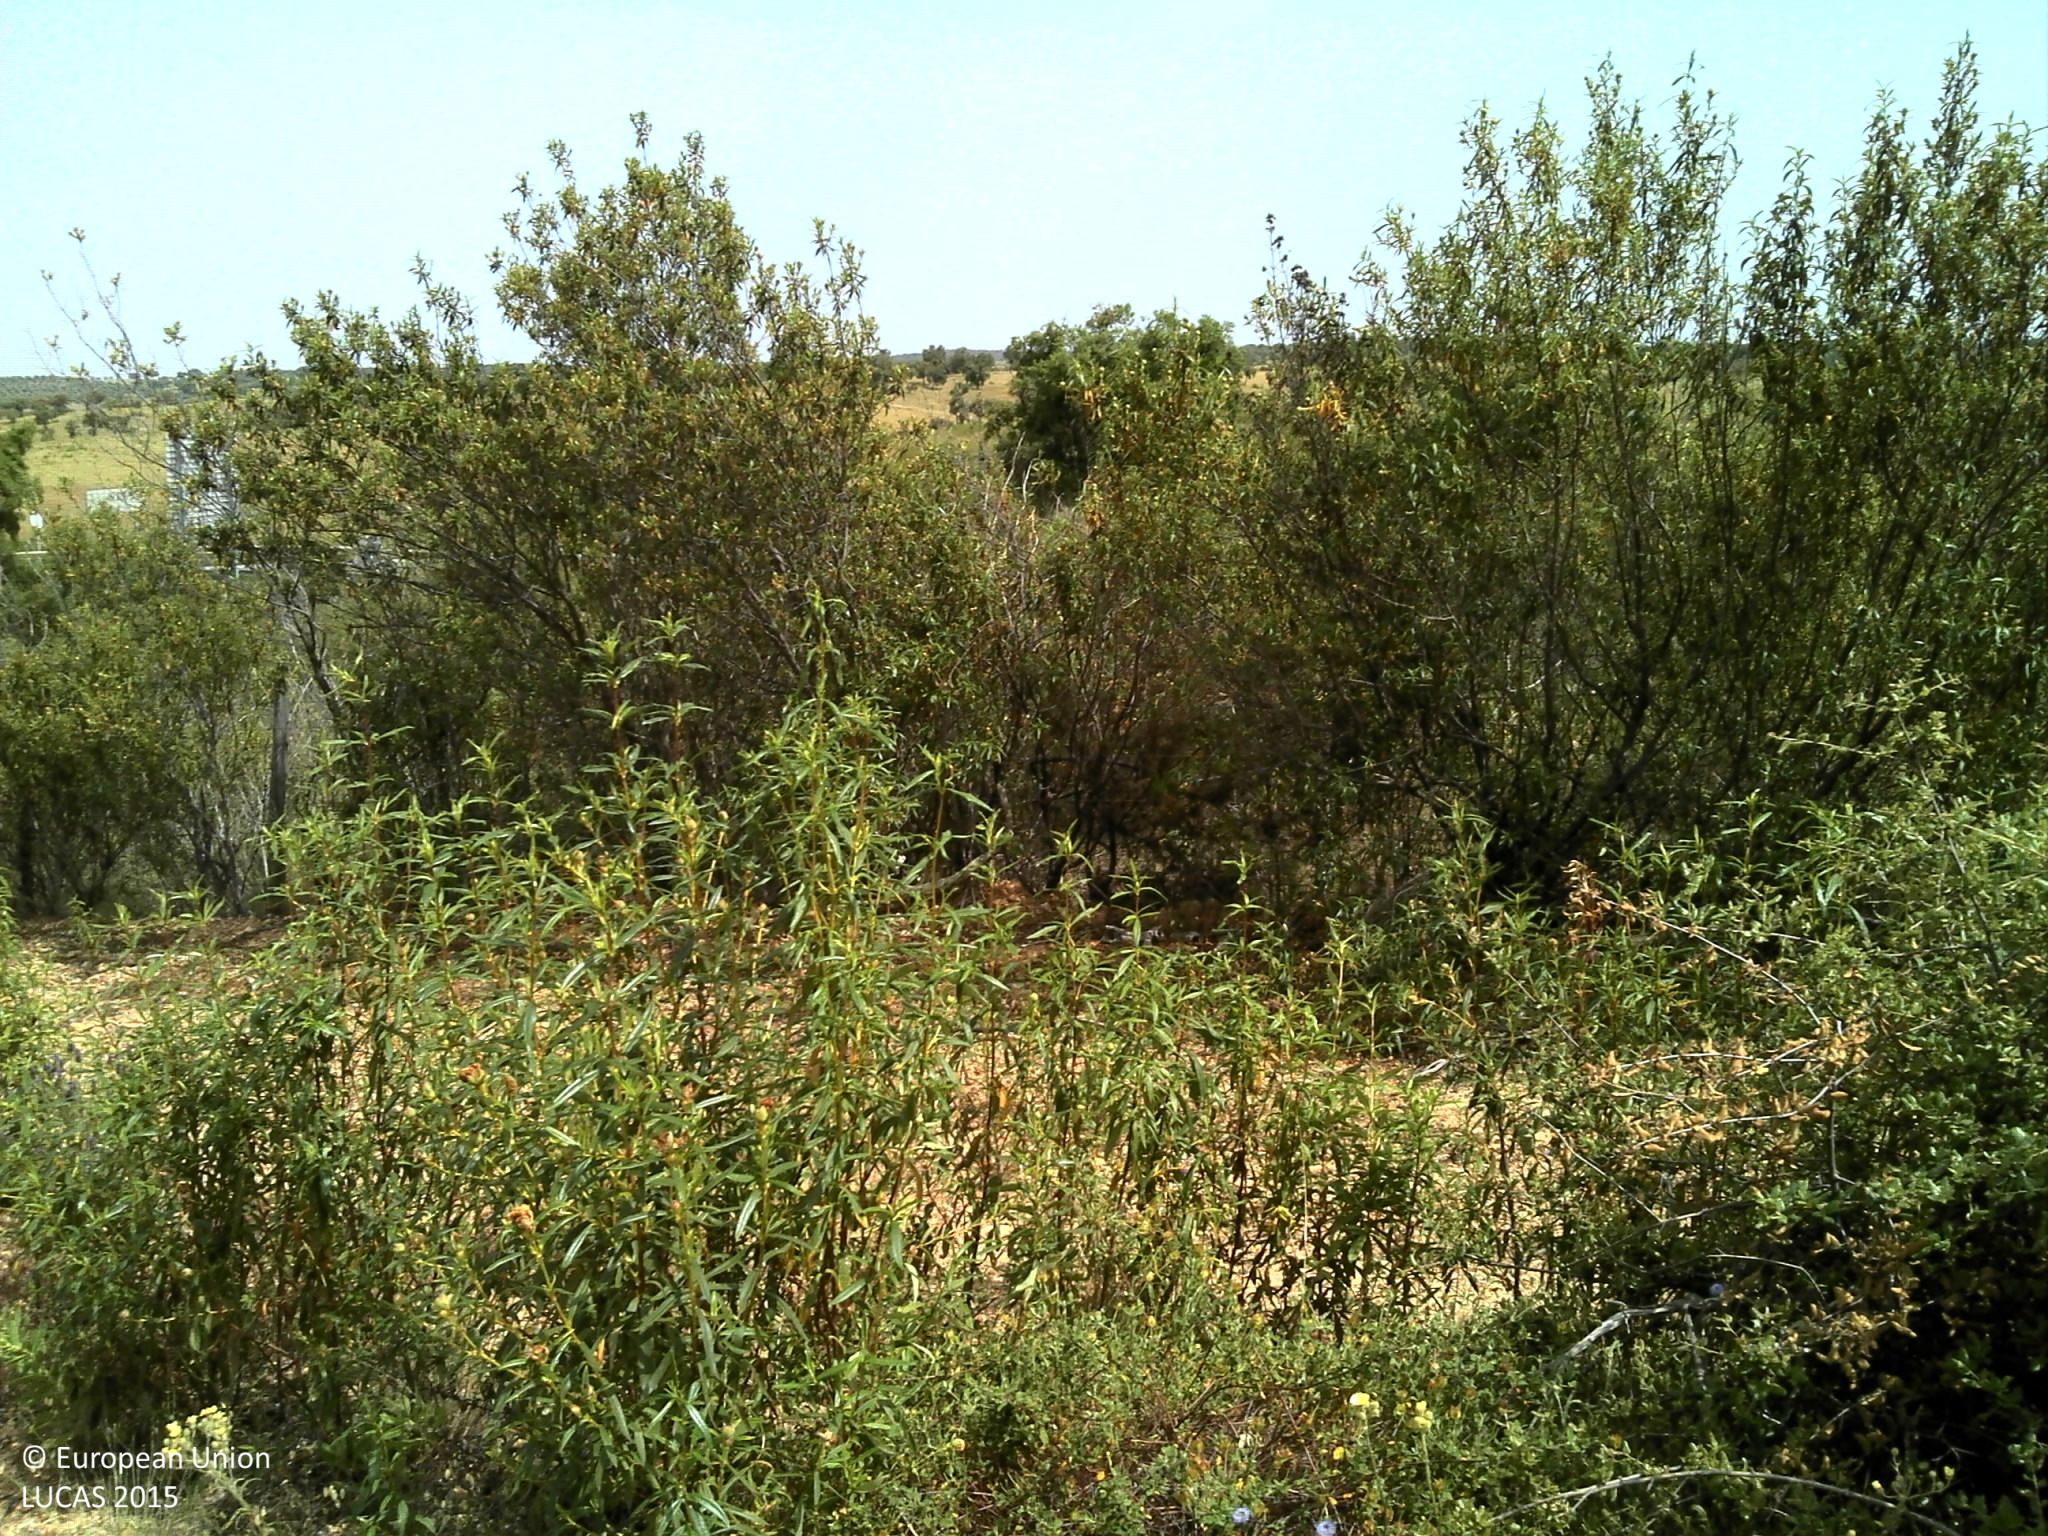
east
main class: Woodland
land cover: Broadleaved woodland
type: broadleaved evergreen forest
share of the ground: 10 - 25 %
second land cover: Grassland without tree/shrub cover
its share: 10 - 25 %
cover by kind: herbaceous plants 30 %, unconsolidated bare surface 30 %, shrubs 25 %, broadleaved forest trees 15 %
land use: Forestry
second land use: Agriculture (excluding fallow land and kitchen gardens)
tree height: > 5 m
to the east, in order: Broadleaved woodland; Grassland without tree/shrub cover; Broadleaved woodland; Shrubland with sparse tree cover; Grass margins; Paved roads, cycling and walking lanes; Grass margins; Broadleaved woodland; Tracks; Fences; Broadleaved woodland; Grassland without tree/shrub cover
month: May
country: PT
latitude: 39.0058
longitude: -7.9357
